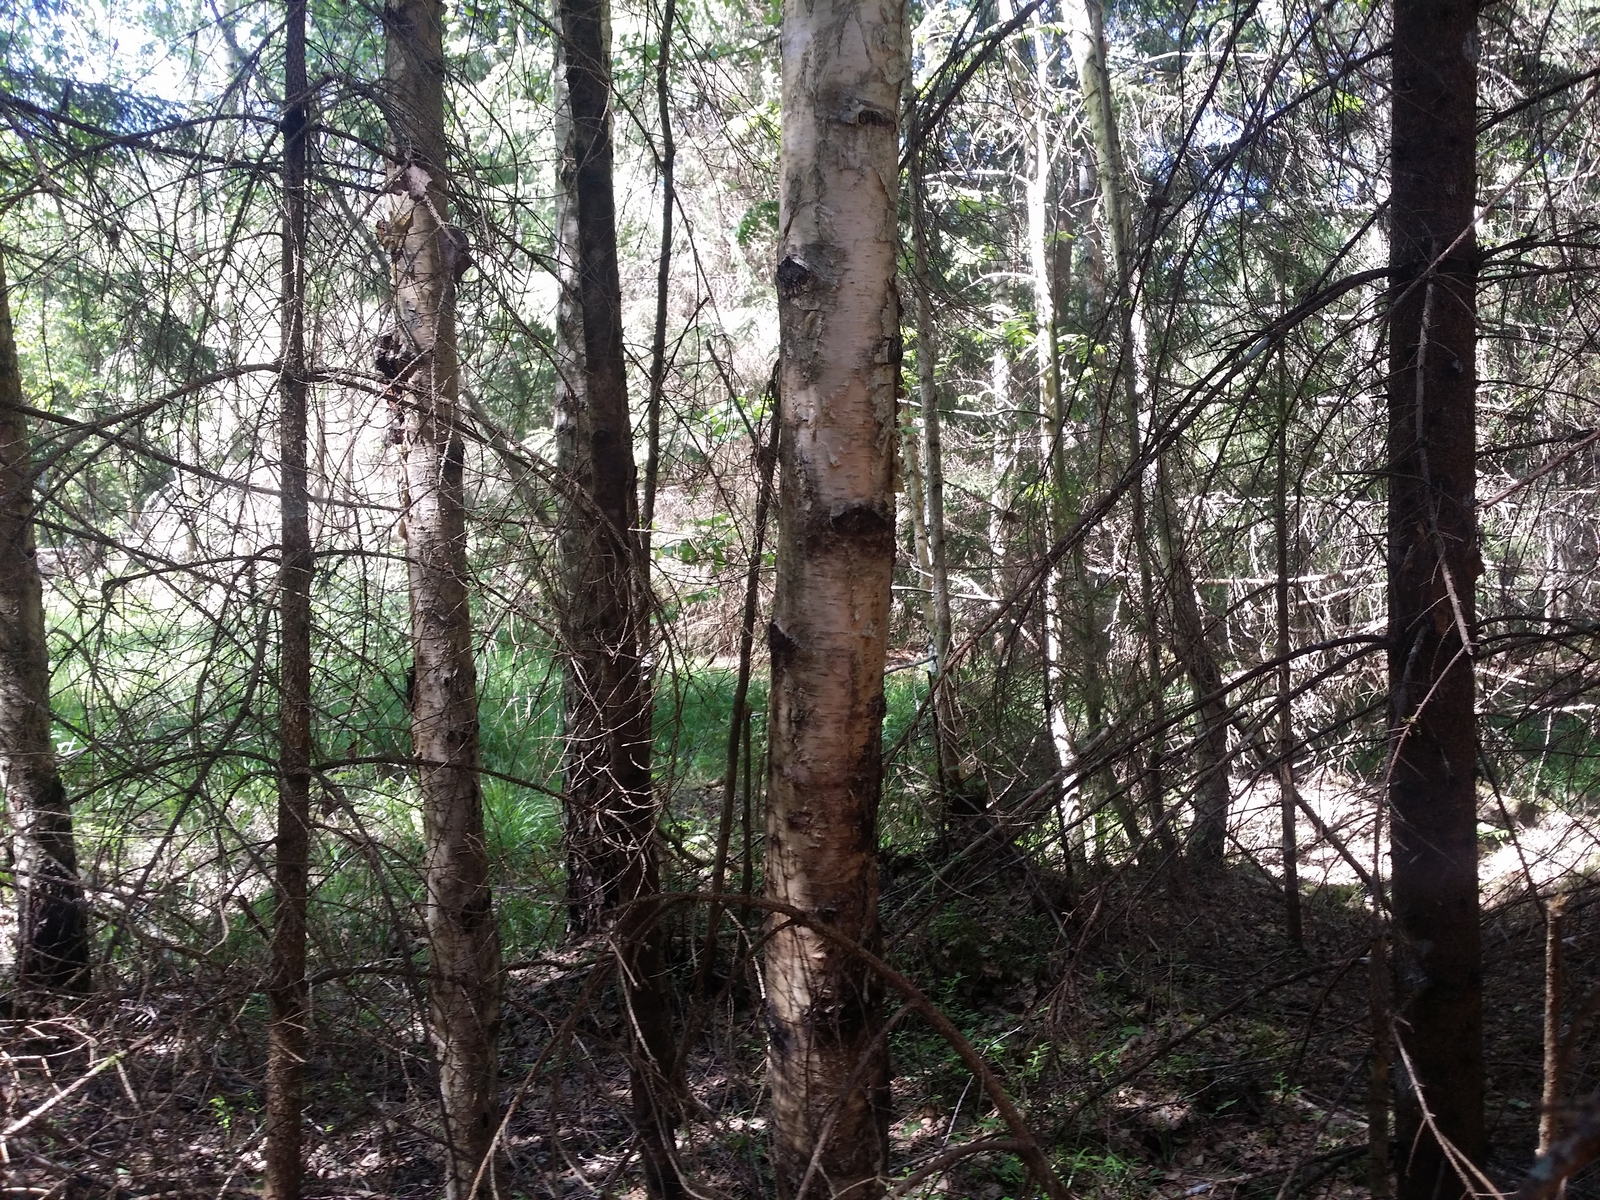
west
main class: Woodland
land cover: Spruce dominated coniferous woodland
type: hemiboreal forest and nemoral coniferous forest and mixed broadleaved-coniferous forest
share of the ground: > 75 %
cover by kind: coniferous forest trees 85 %, lichens and mosses 10 %, herbaceous plants 5 %
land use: Forestry
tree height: > 5 m
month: June
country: LV
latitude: 57.2736
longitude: 26.4108
